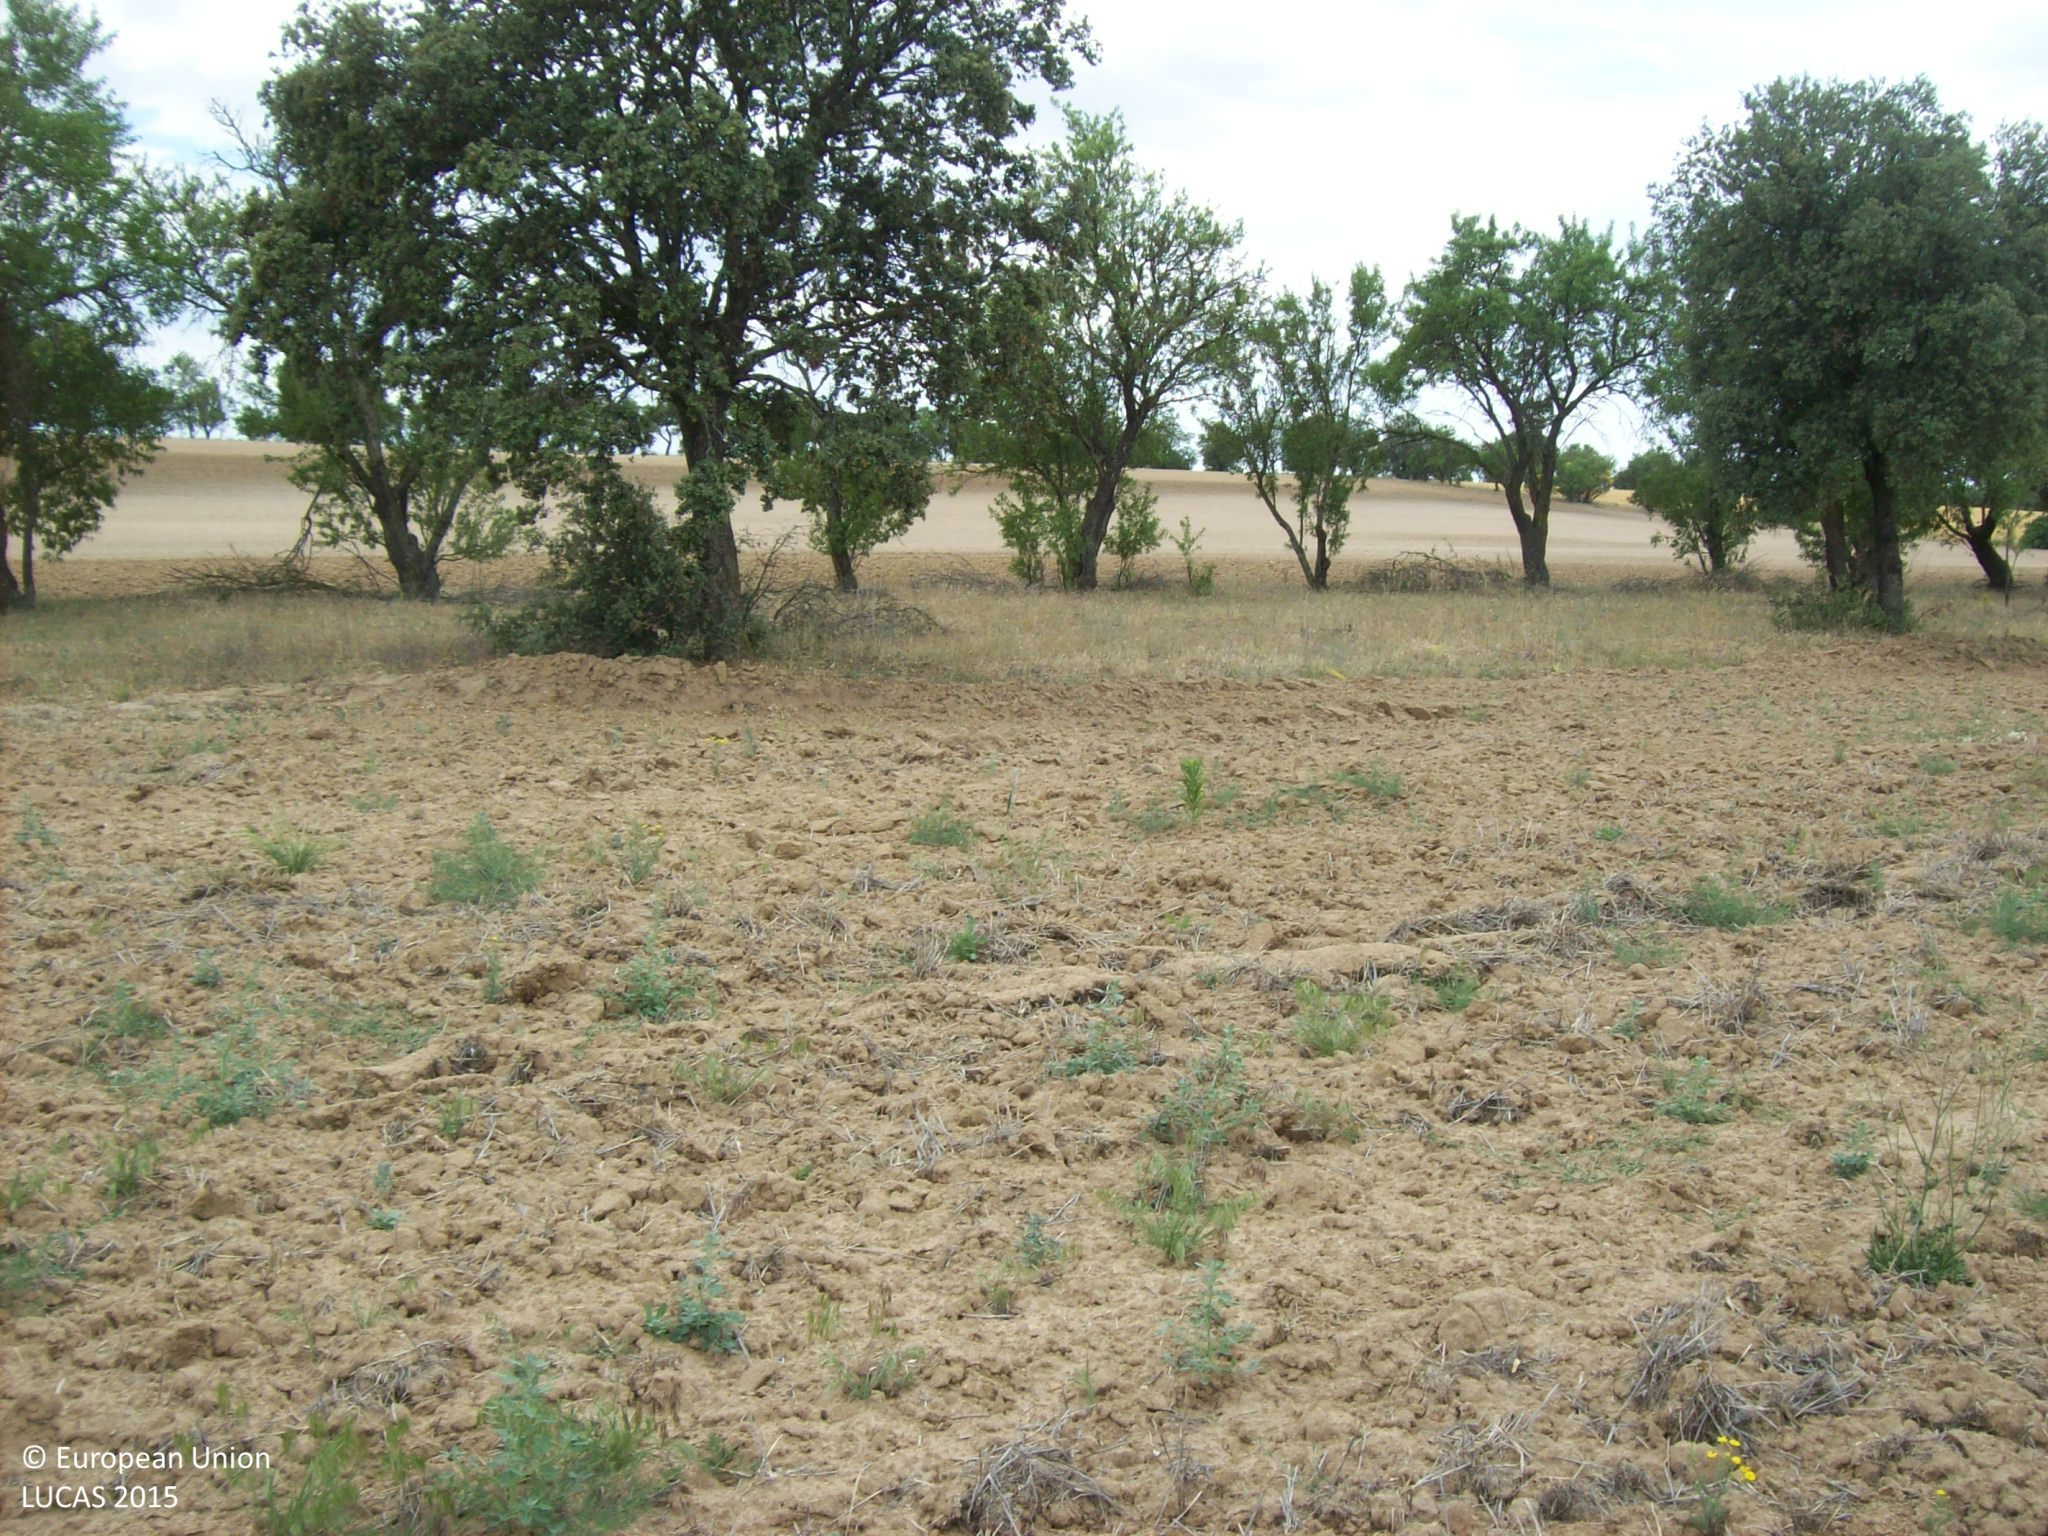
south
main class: Grassland
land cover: Spontaneously vegetated surfaces
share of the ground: 10 - 25 %
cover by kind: unconsolidated bare surface 85 %, herbaceous plants 15 %
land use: Fallow land
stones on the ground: < 10 %
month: June
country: ES
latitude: 41.1769
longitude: -5.0284
